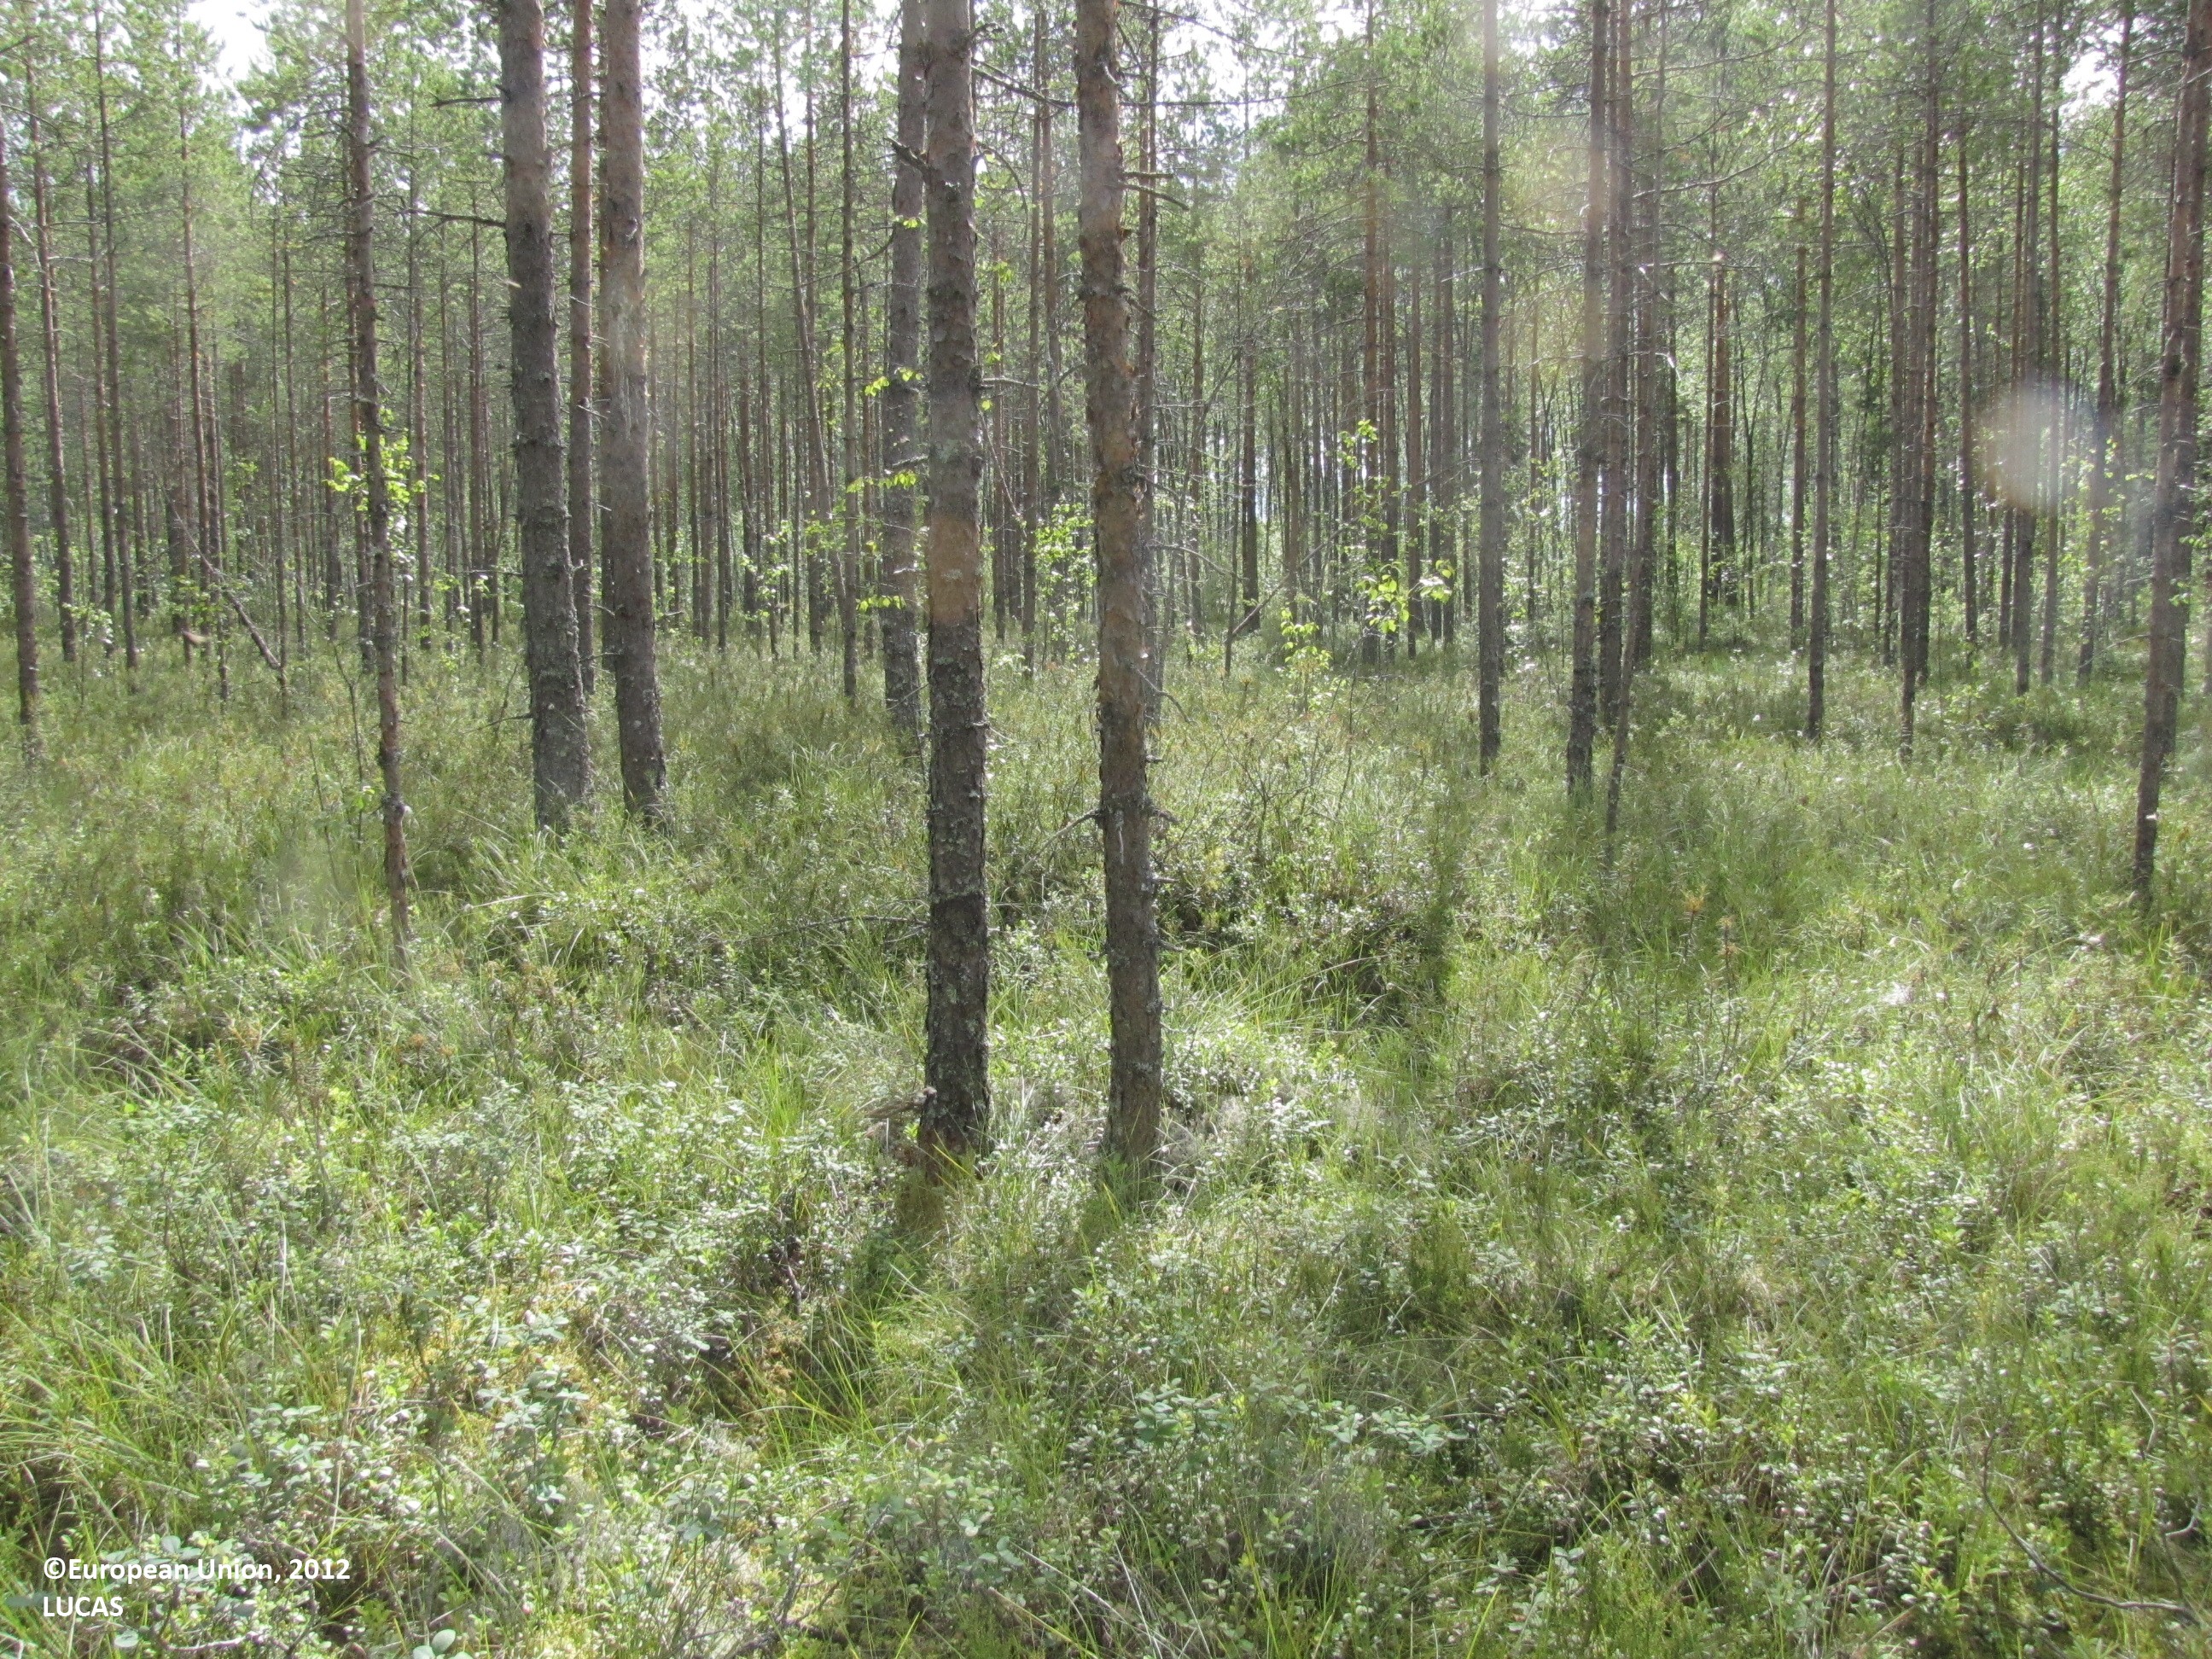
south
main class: Woodland
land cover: Pine dominated coniferous woodland
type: boreal forest
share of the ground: 50 - 75 %
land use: Forestry
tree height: > 5 m
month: July
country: FI
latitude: 62.6306
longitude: 23.2265
